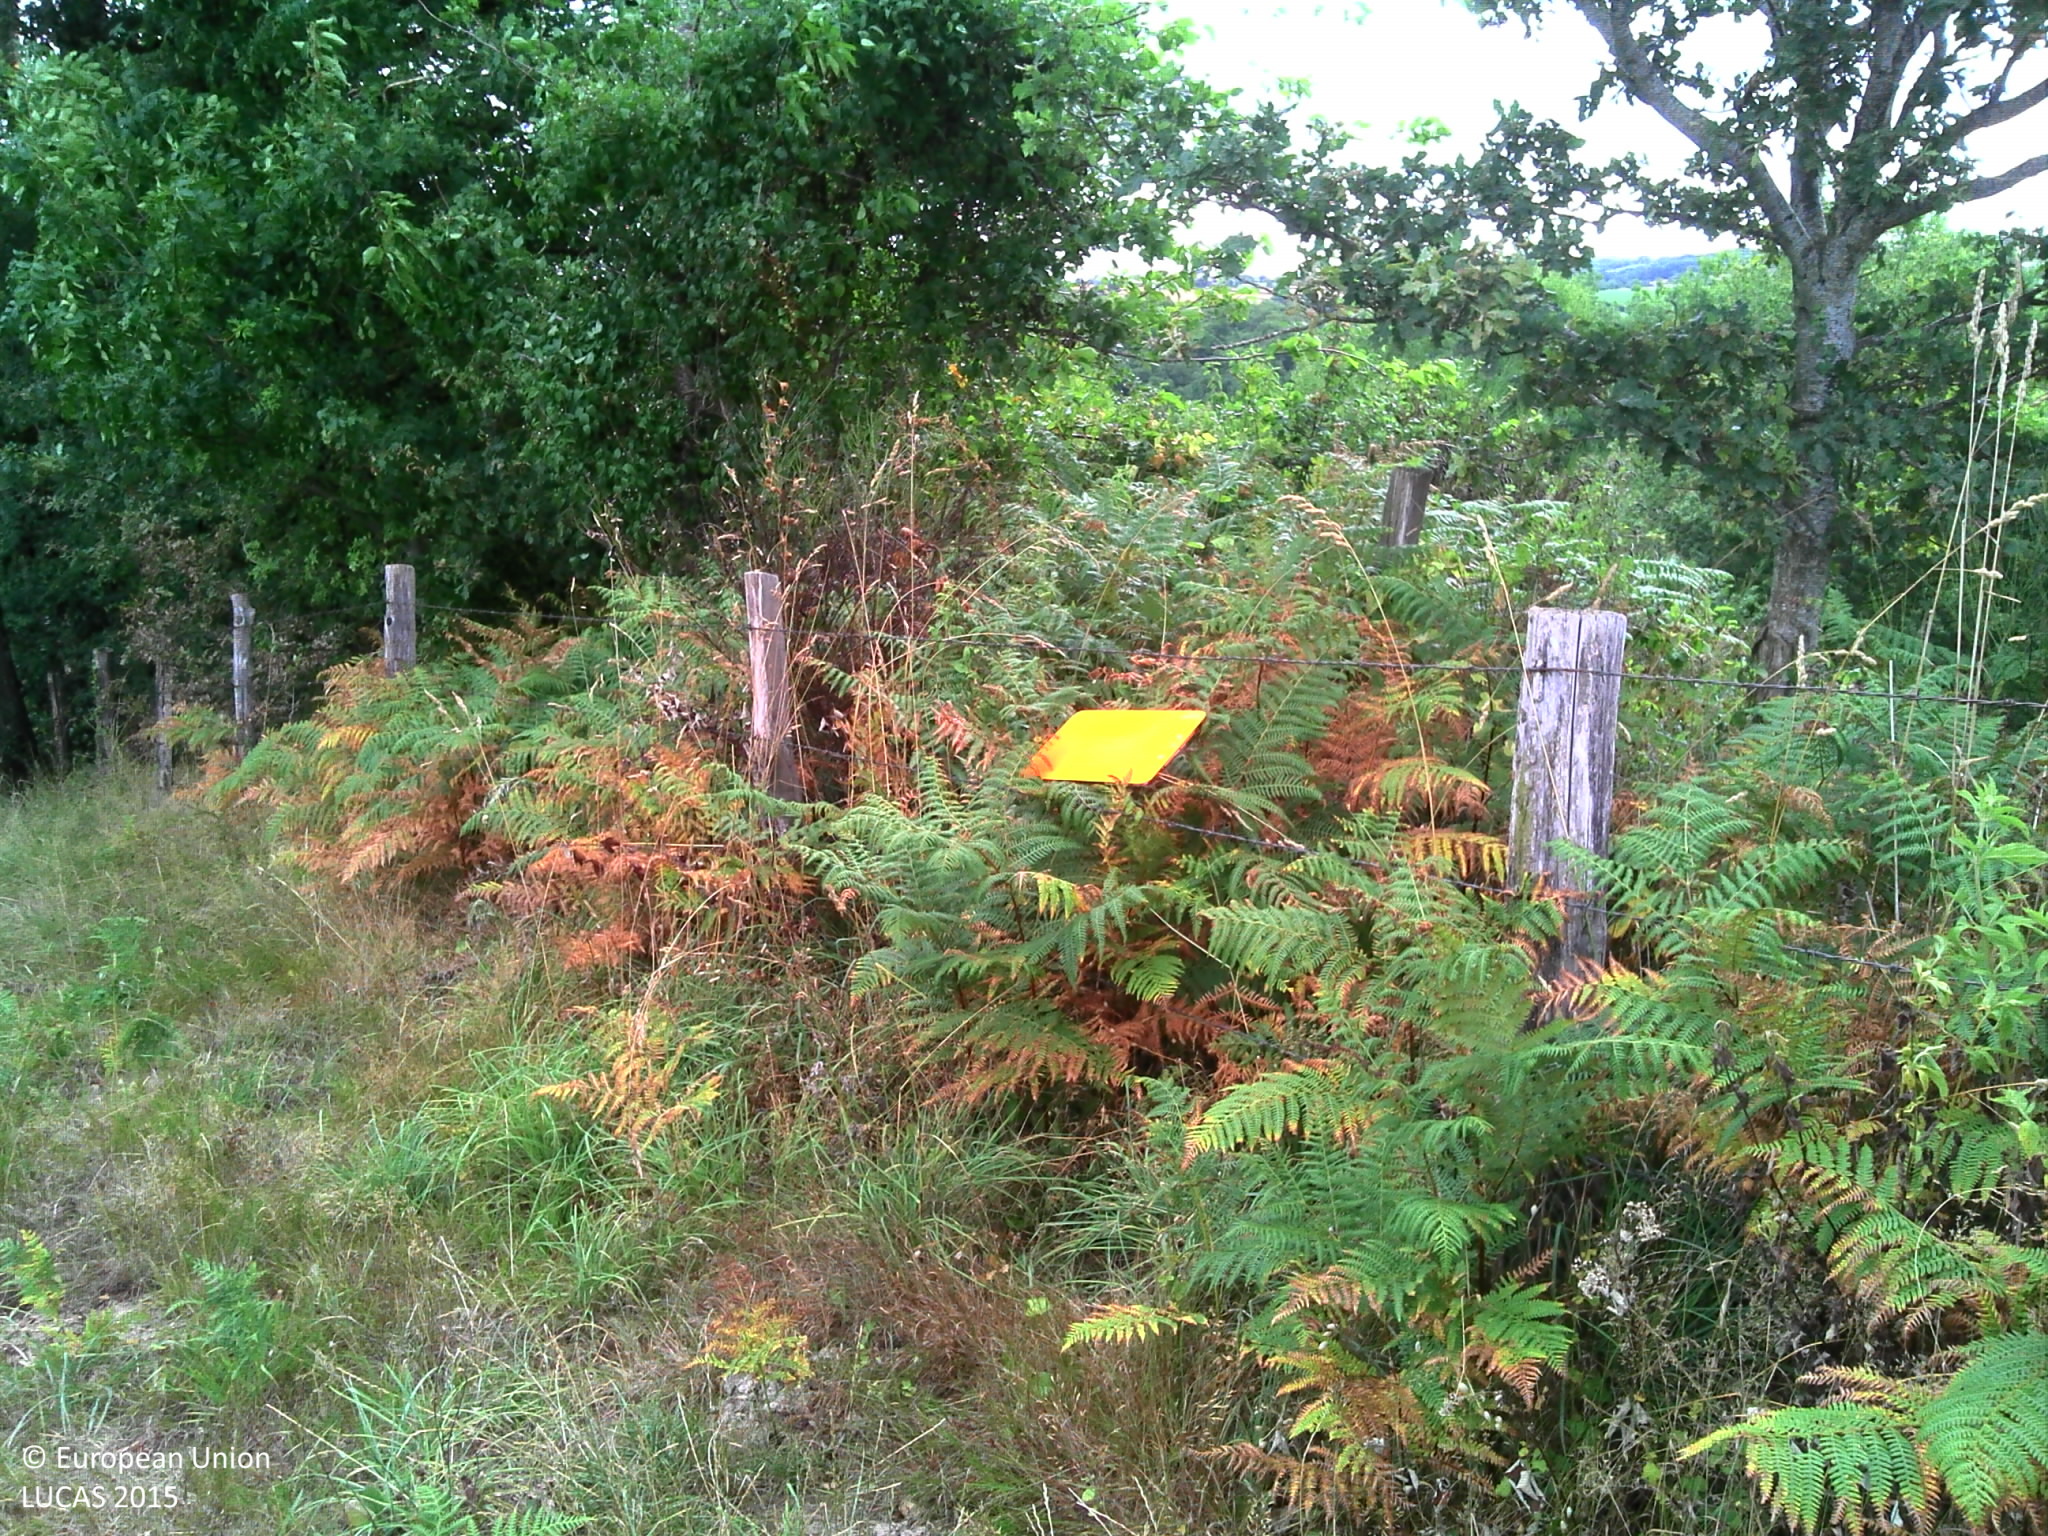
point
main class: Grassland
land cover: Grassland without tree/shrub cover
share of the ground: > 75 %
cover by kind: herbaceous plants 100 %
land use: Agriculture (excluding fallow land and kitchen gardens)
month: July
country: FR
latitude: 44.0448
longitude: 2.5289
